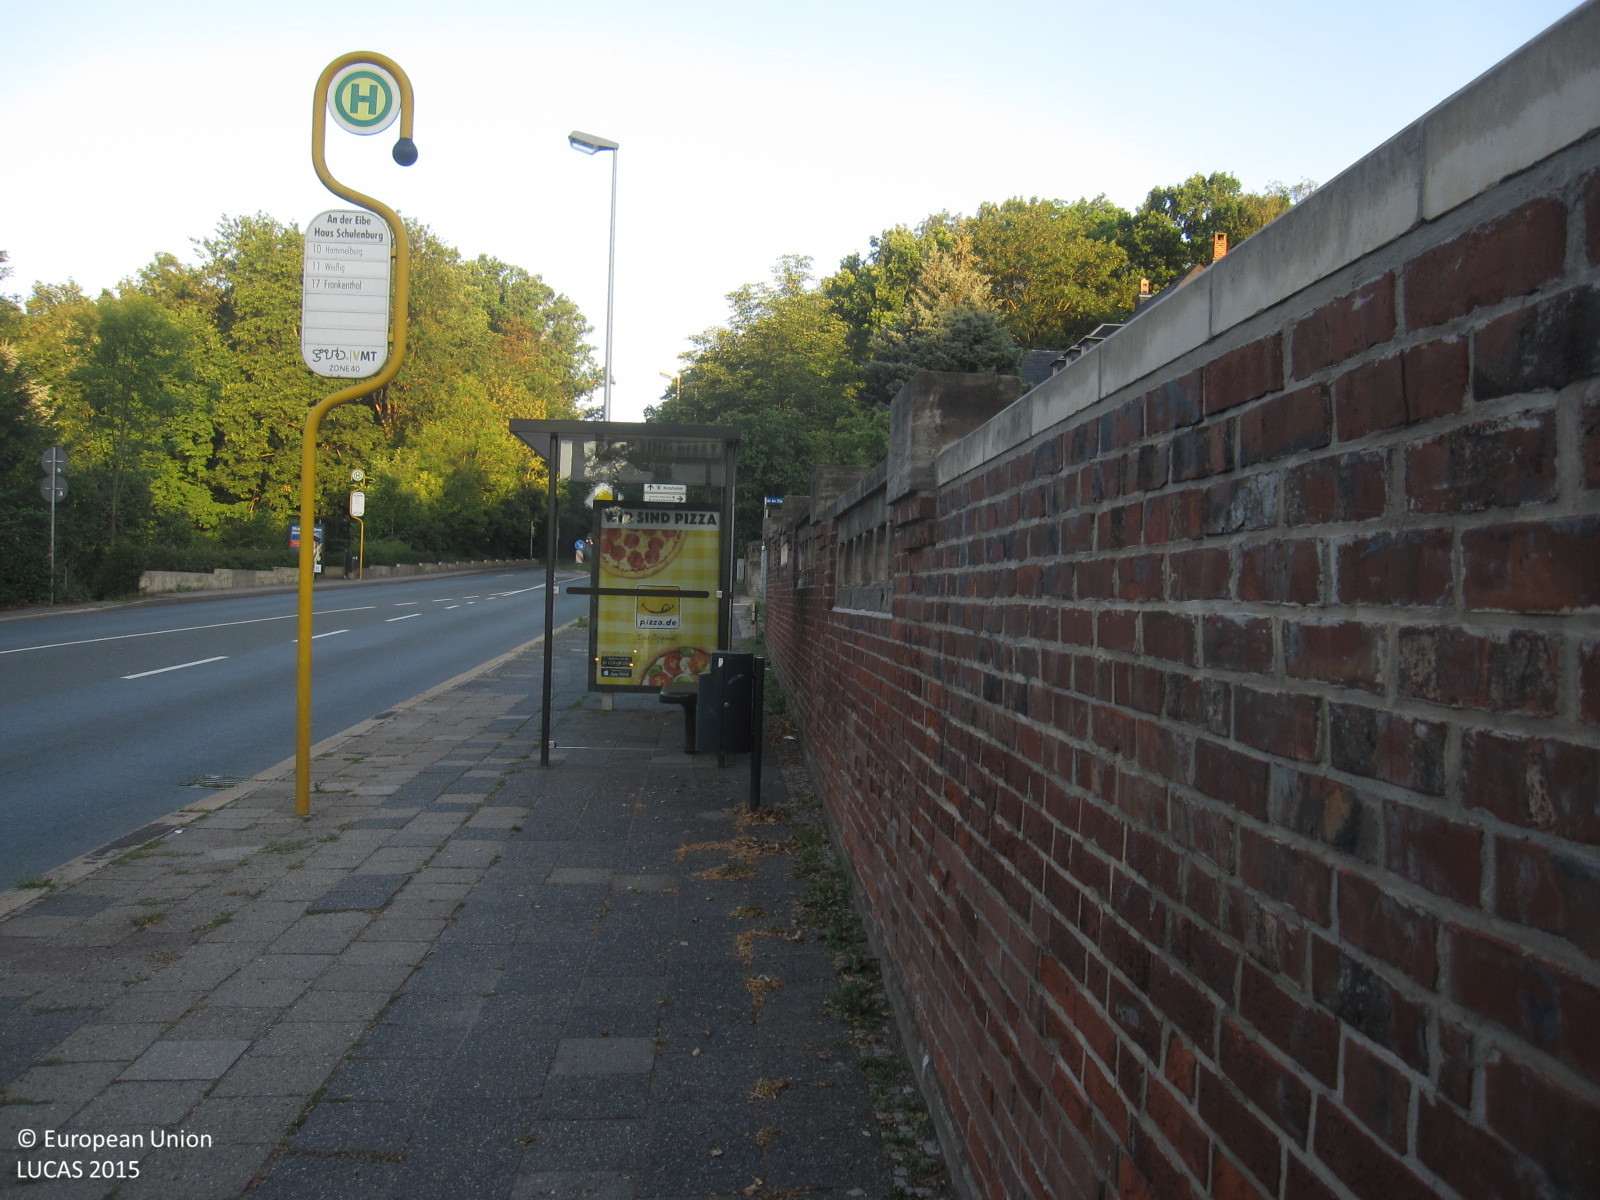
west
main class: Grassland
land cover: Grassland with sparse tree/shrub cover
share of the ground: > 75 %
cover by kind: herbaceous plants 95 %, broadleaved forest trees 5 %
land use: Residential
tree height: > 5 m
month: July
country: DE
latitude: 50.8671
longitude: 12.0600
